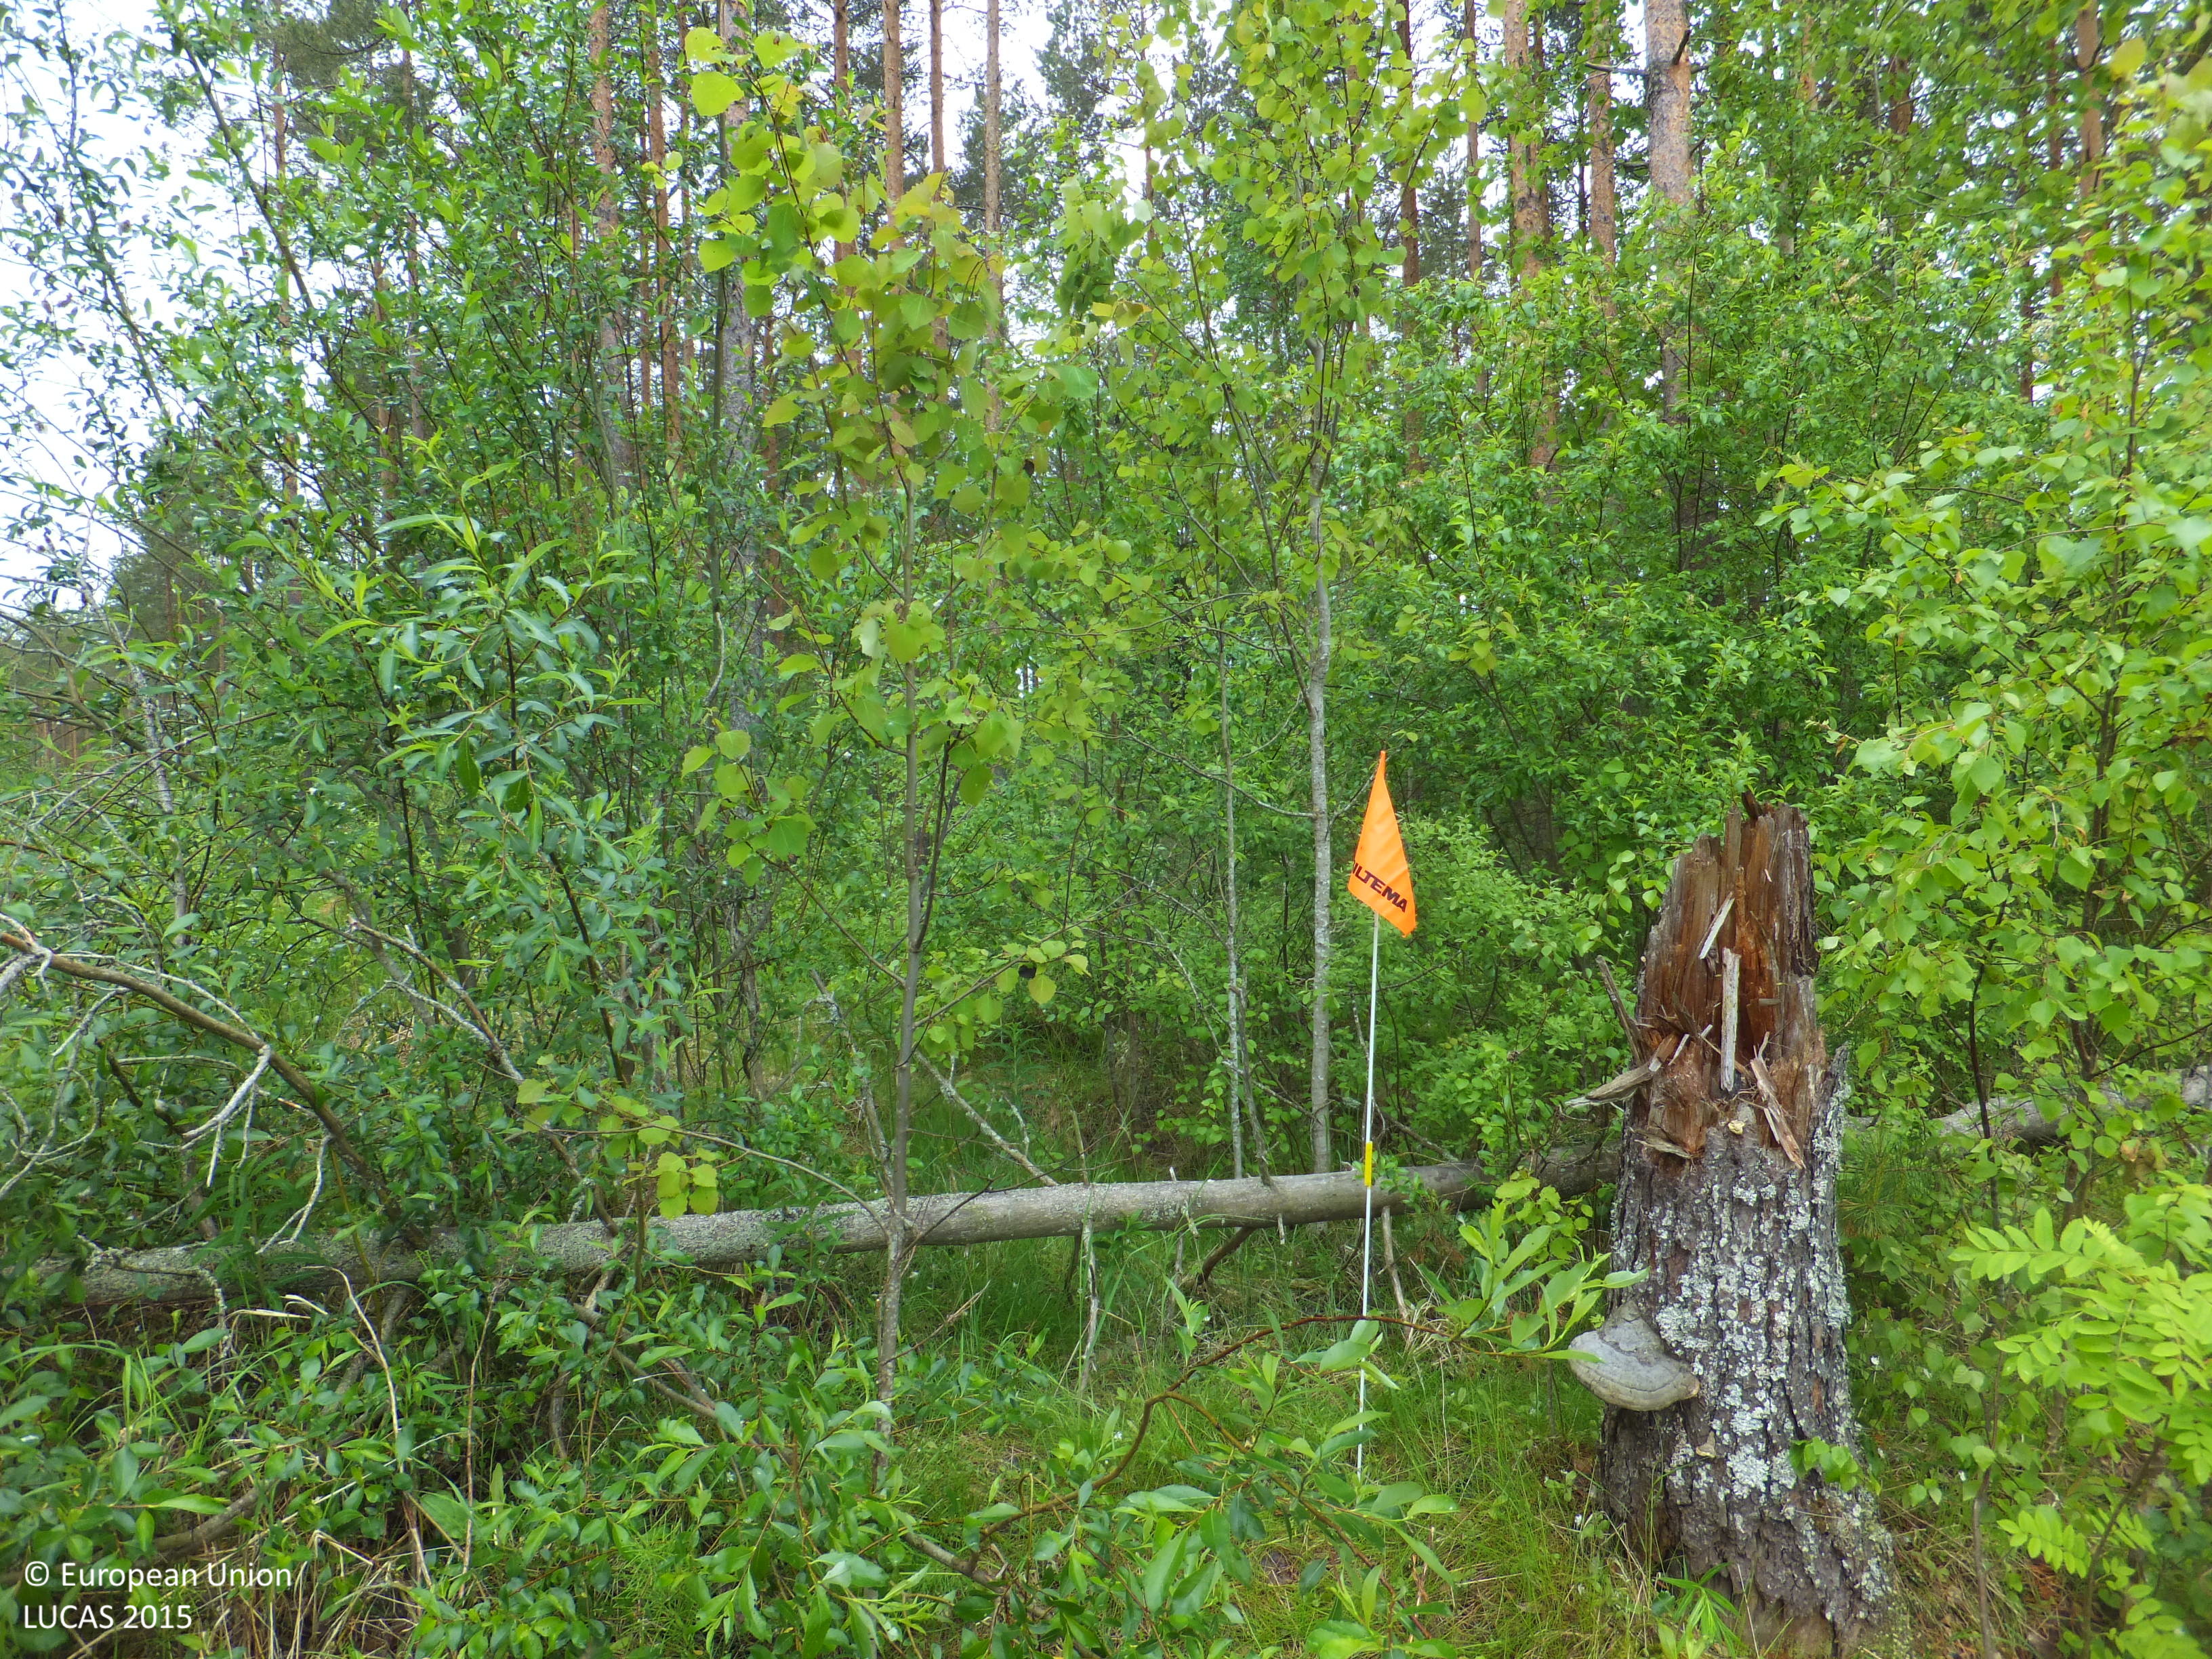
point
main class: Woodland
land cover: Pine dominated mixed woodland
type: boreal forest
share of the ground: > 75 %
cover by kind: coniferous forest trees 55 %, broadleaved forest trees 20 %, shrubs 15 %, herbaceous plants 5 %, lichens and mosses 5 %
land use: Forestry
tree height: > 5 m
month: June
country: FI
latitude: 63.4563
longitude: 23.8475
